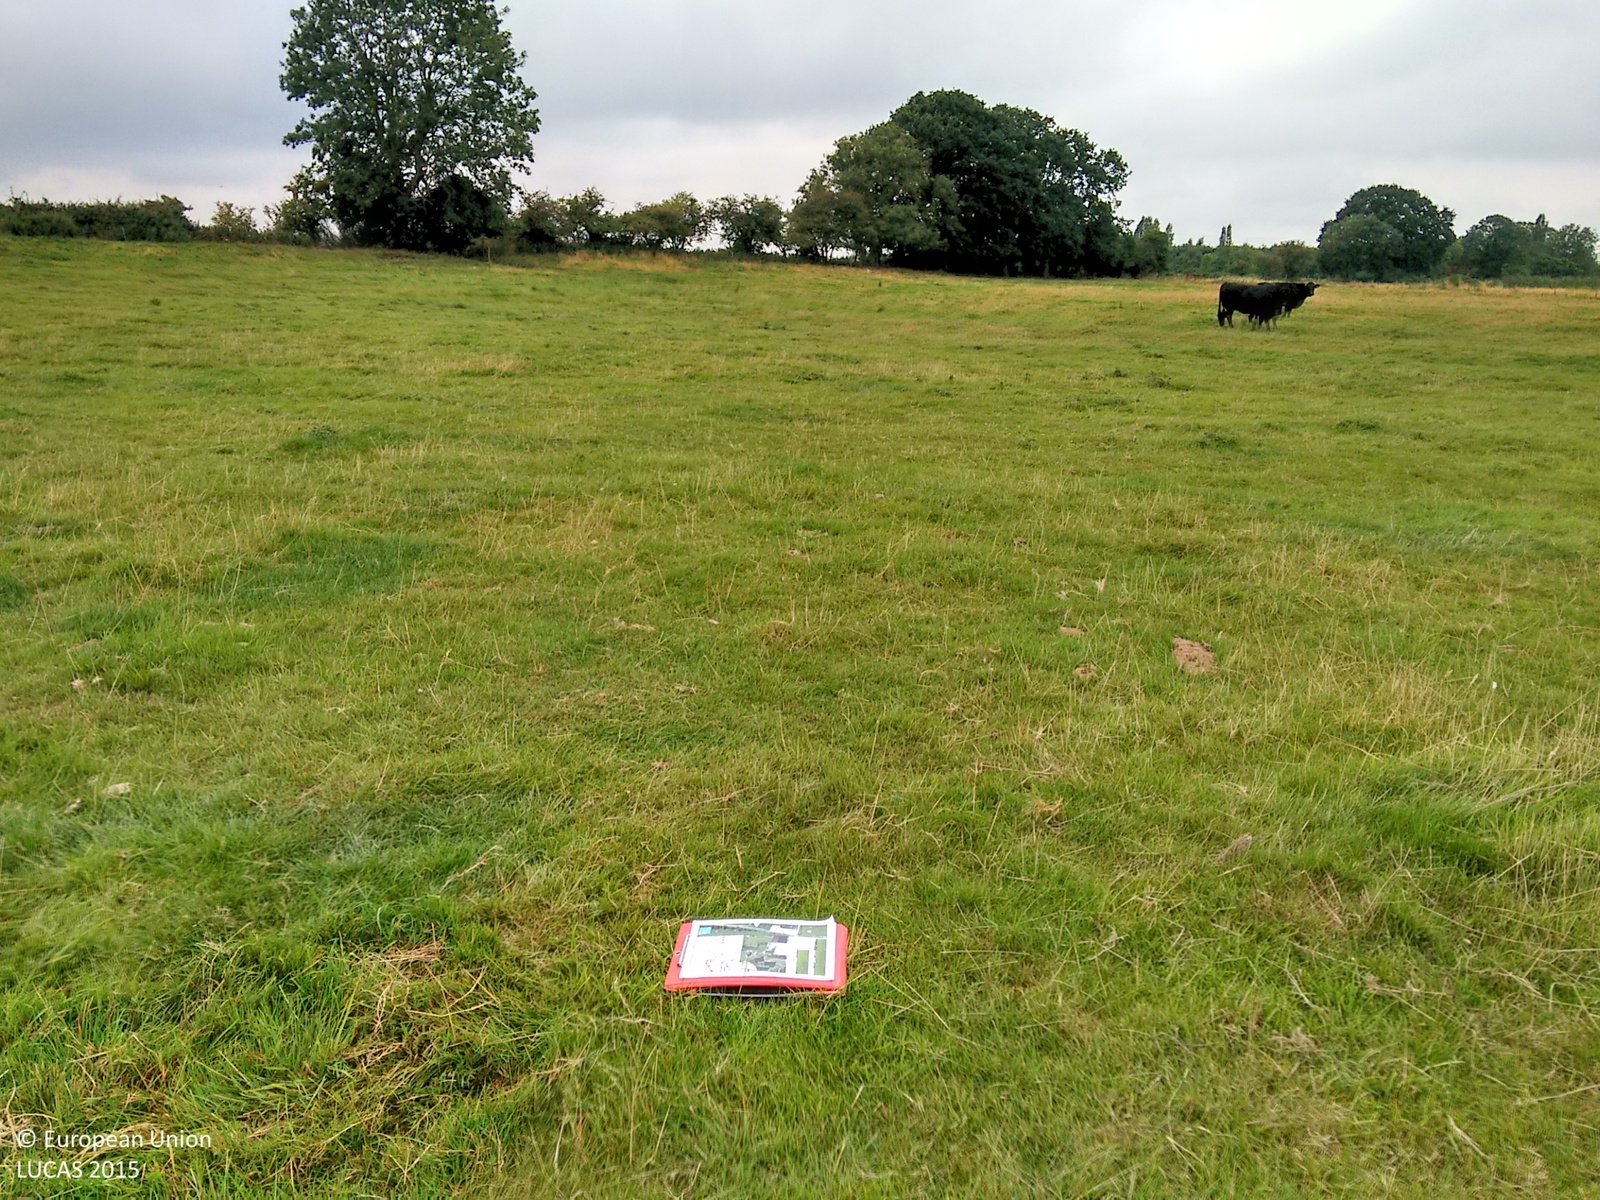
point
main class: Grassland
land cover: Grassland without tree/shrub cover
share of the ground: > 75 %
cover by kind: herbaceous plants 100 %
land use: Agriculture (excluding fallow land and kitchen gardens)
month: August
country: GB
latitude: 52.6450
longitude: 0.4690
